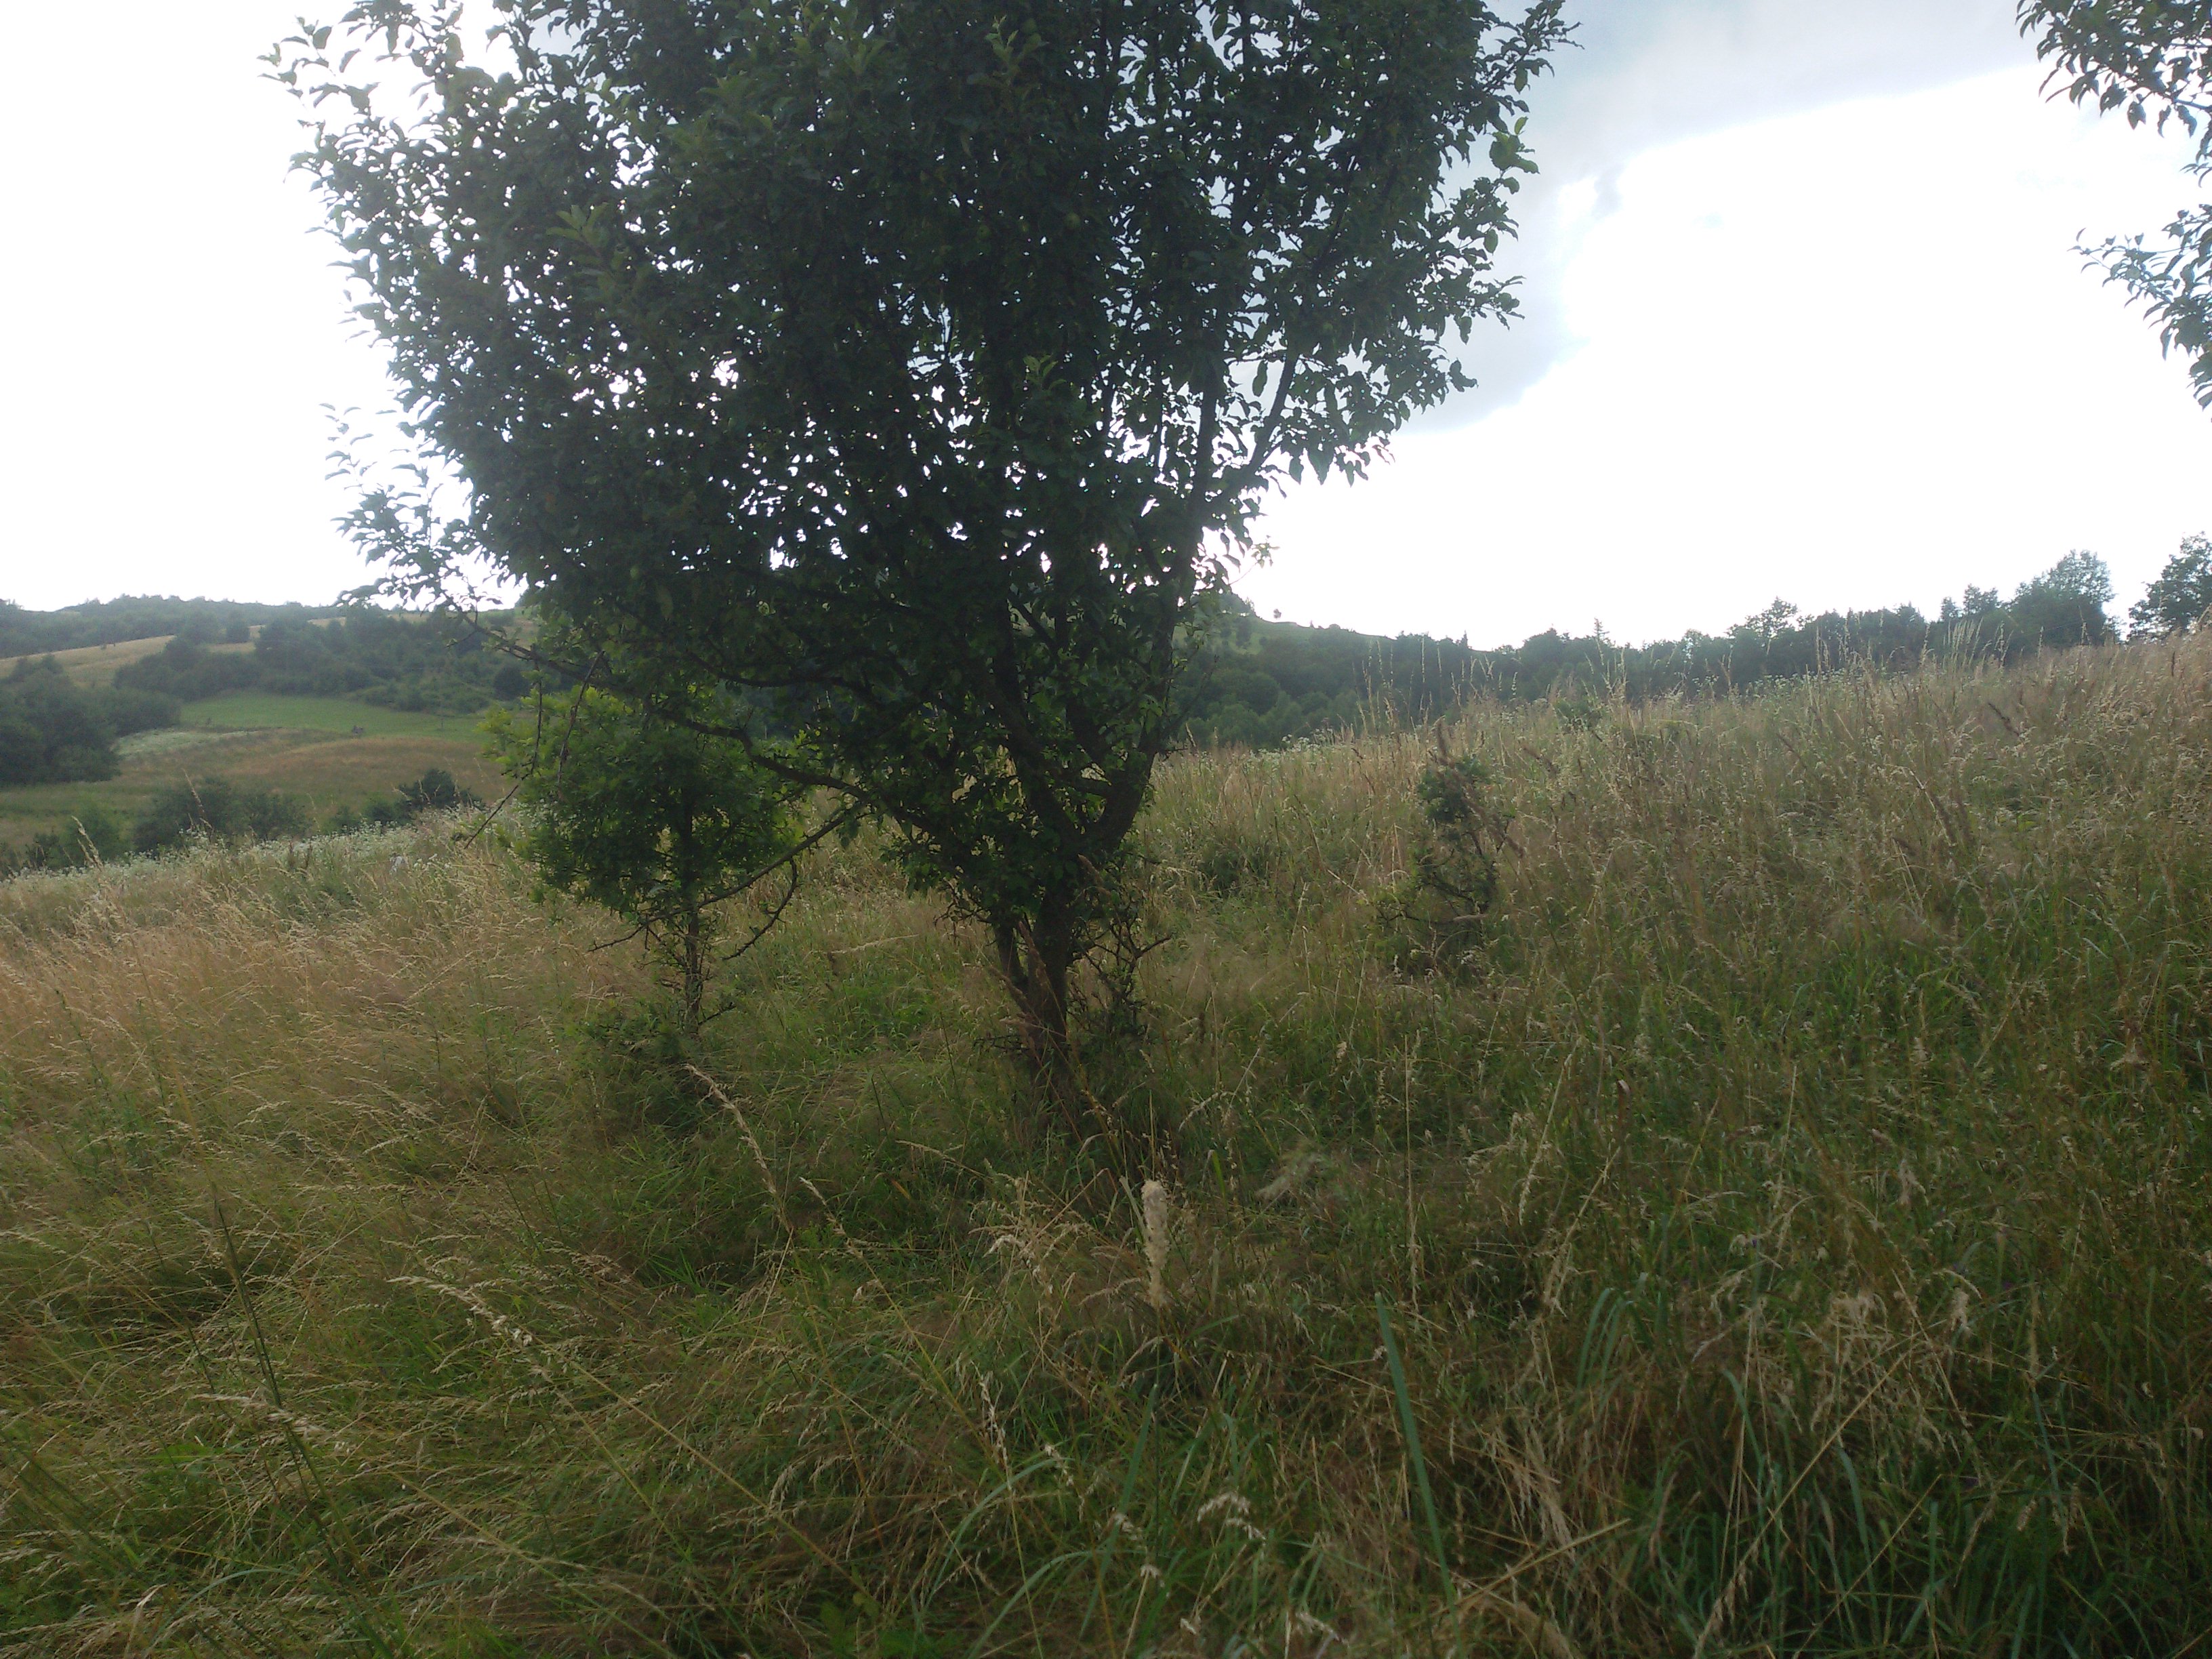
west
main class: Grassland
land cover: Grassland with sparse tree/shrub cover
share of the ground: > 75 %
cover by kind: herbaceous plants 90 %, broadleaved forest trees 5 %, shrubs 5 %
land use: Semi-natural and natural areas not in use
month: July
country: PL
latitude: 49.6673
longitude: 22.2395
